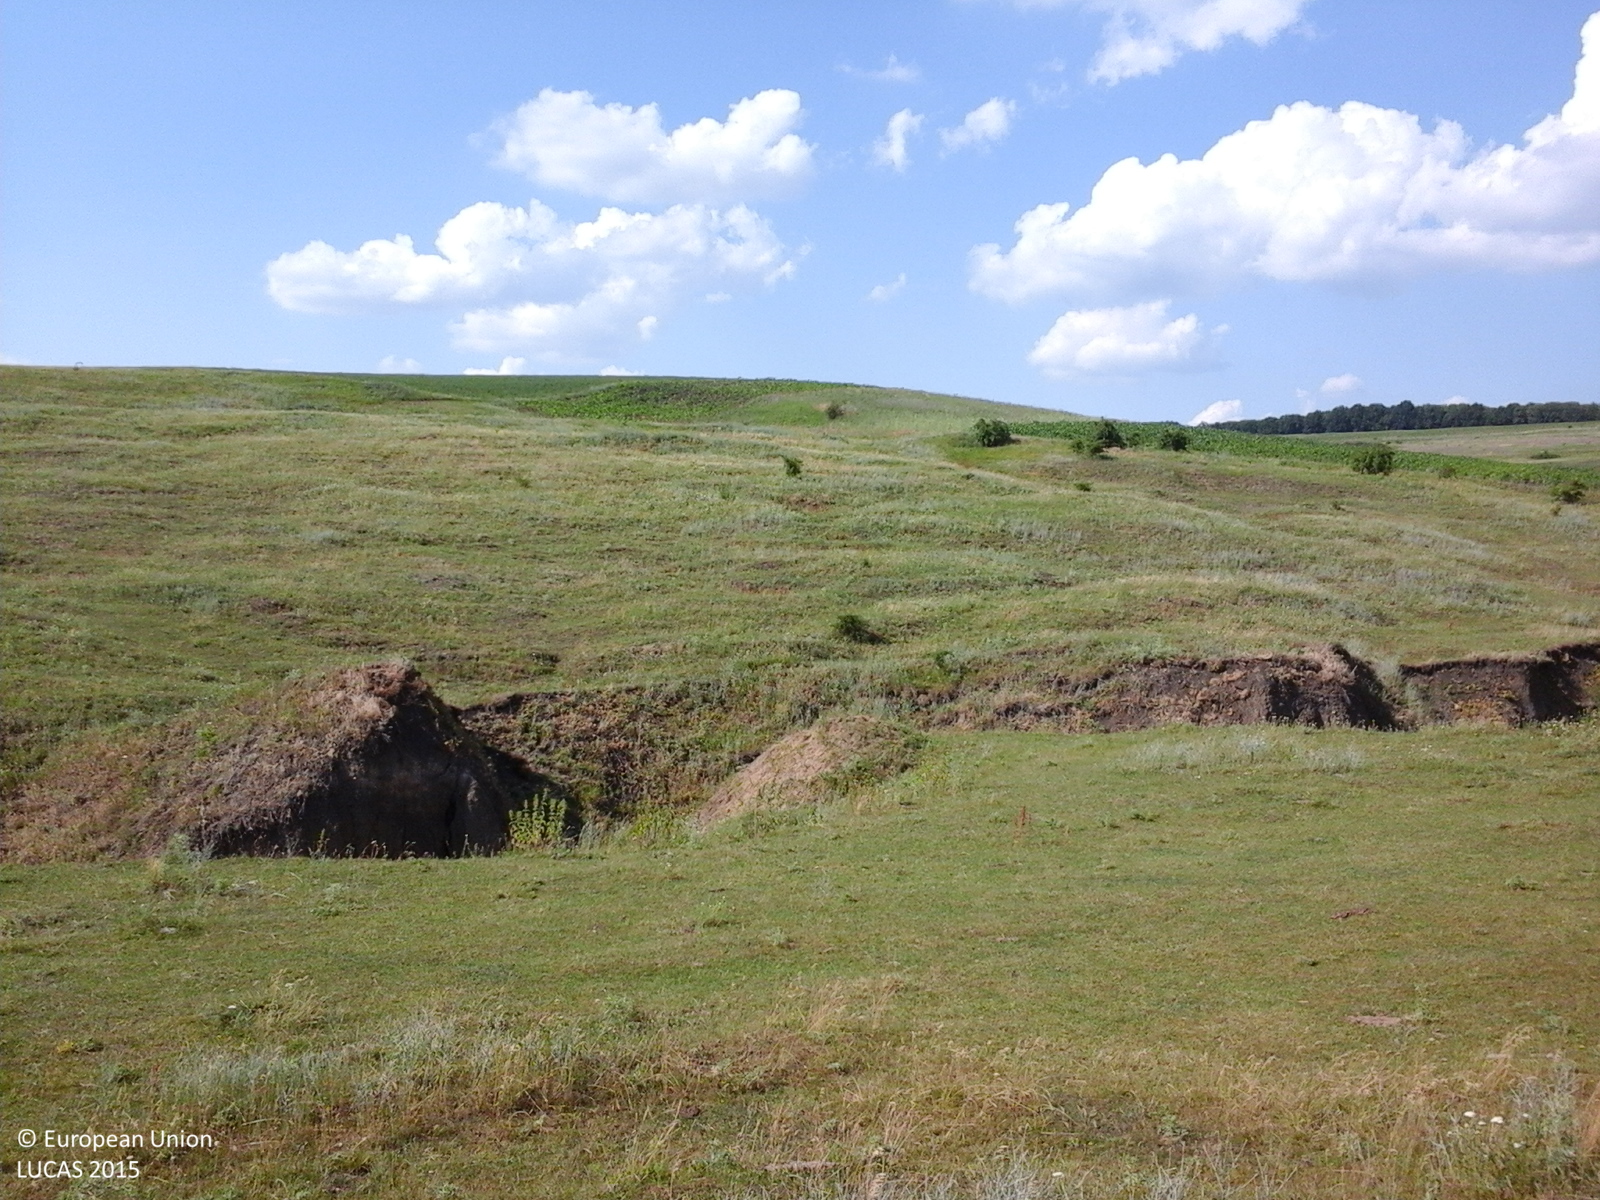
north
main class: Grassland
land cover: Grassland without tree/shrub cover
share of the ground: > 75 %
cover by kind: herbaceous plants 100 %
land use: Agriculture (excluding fallow land and kitchen gardens)
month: June
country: RO
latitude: 47.6044
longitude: 26.9008
